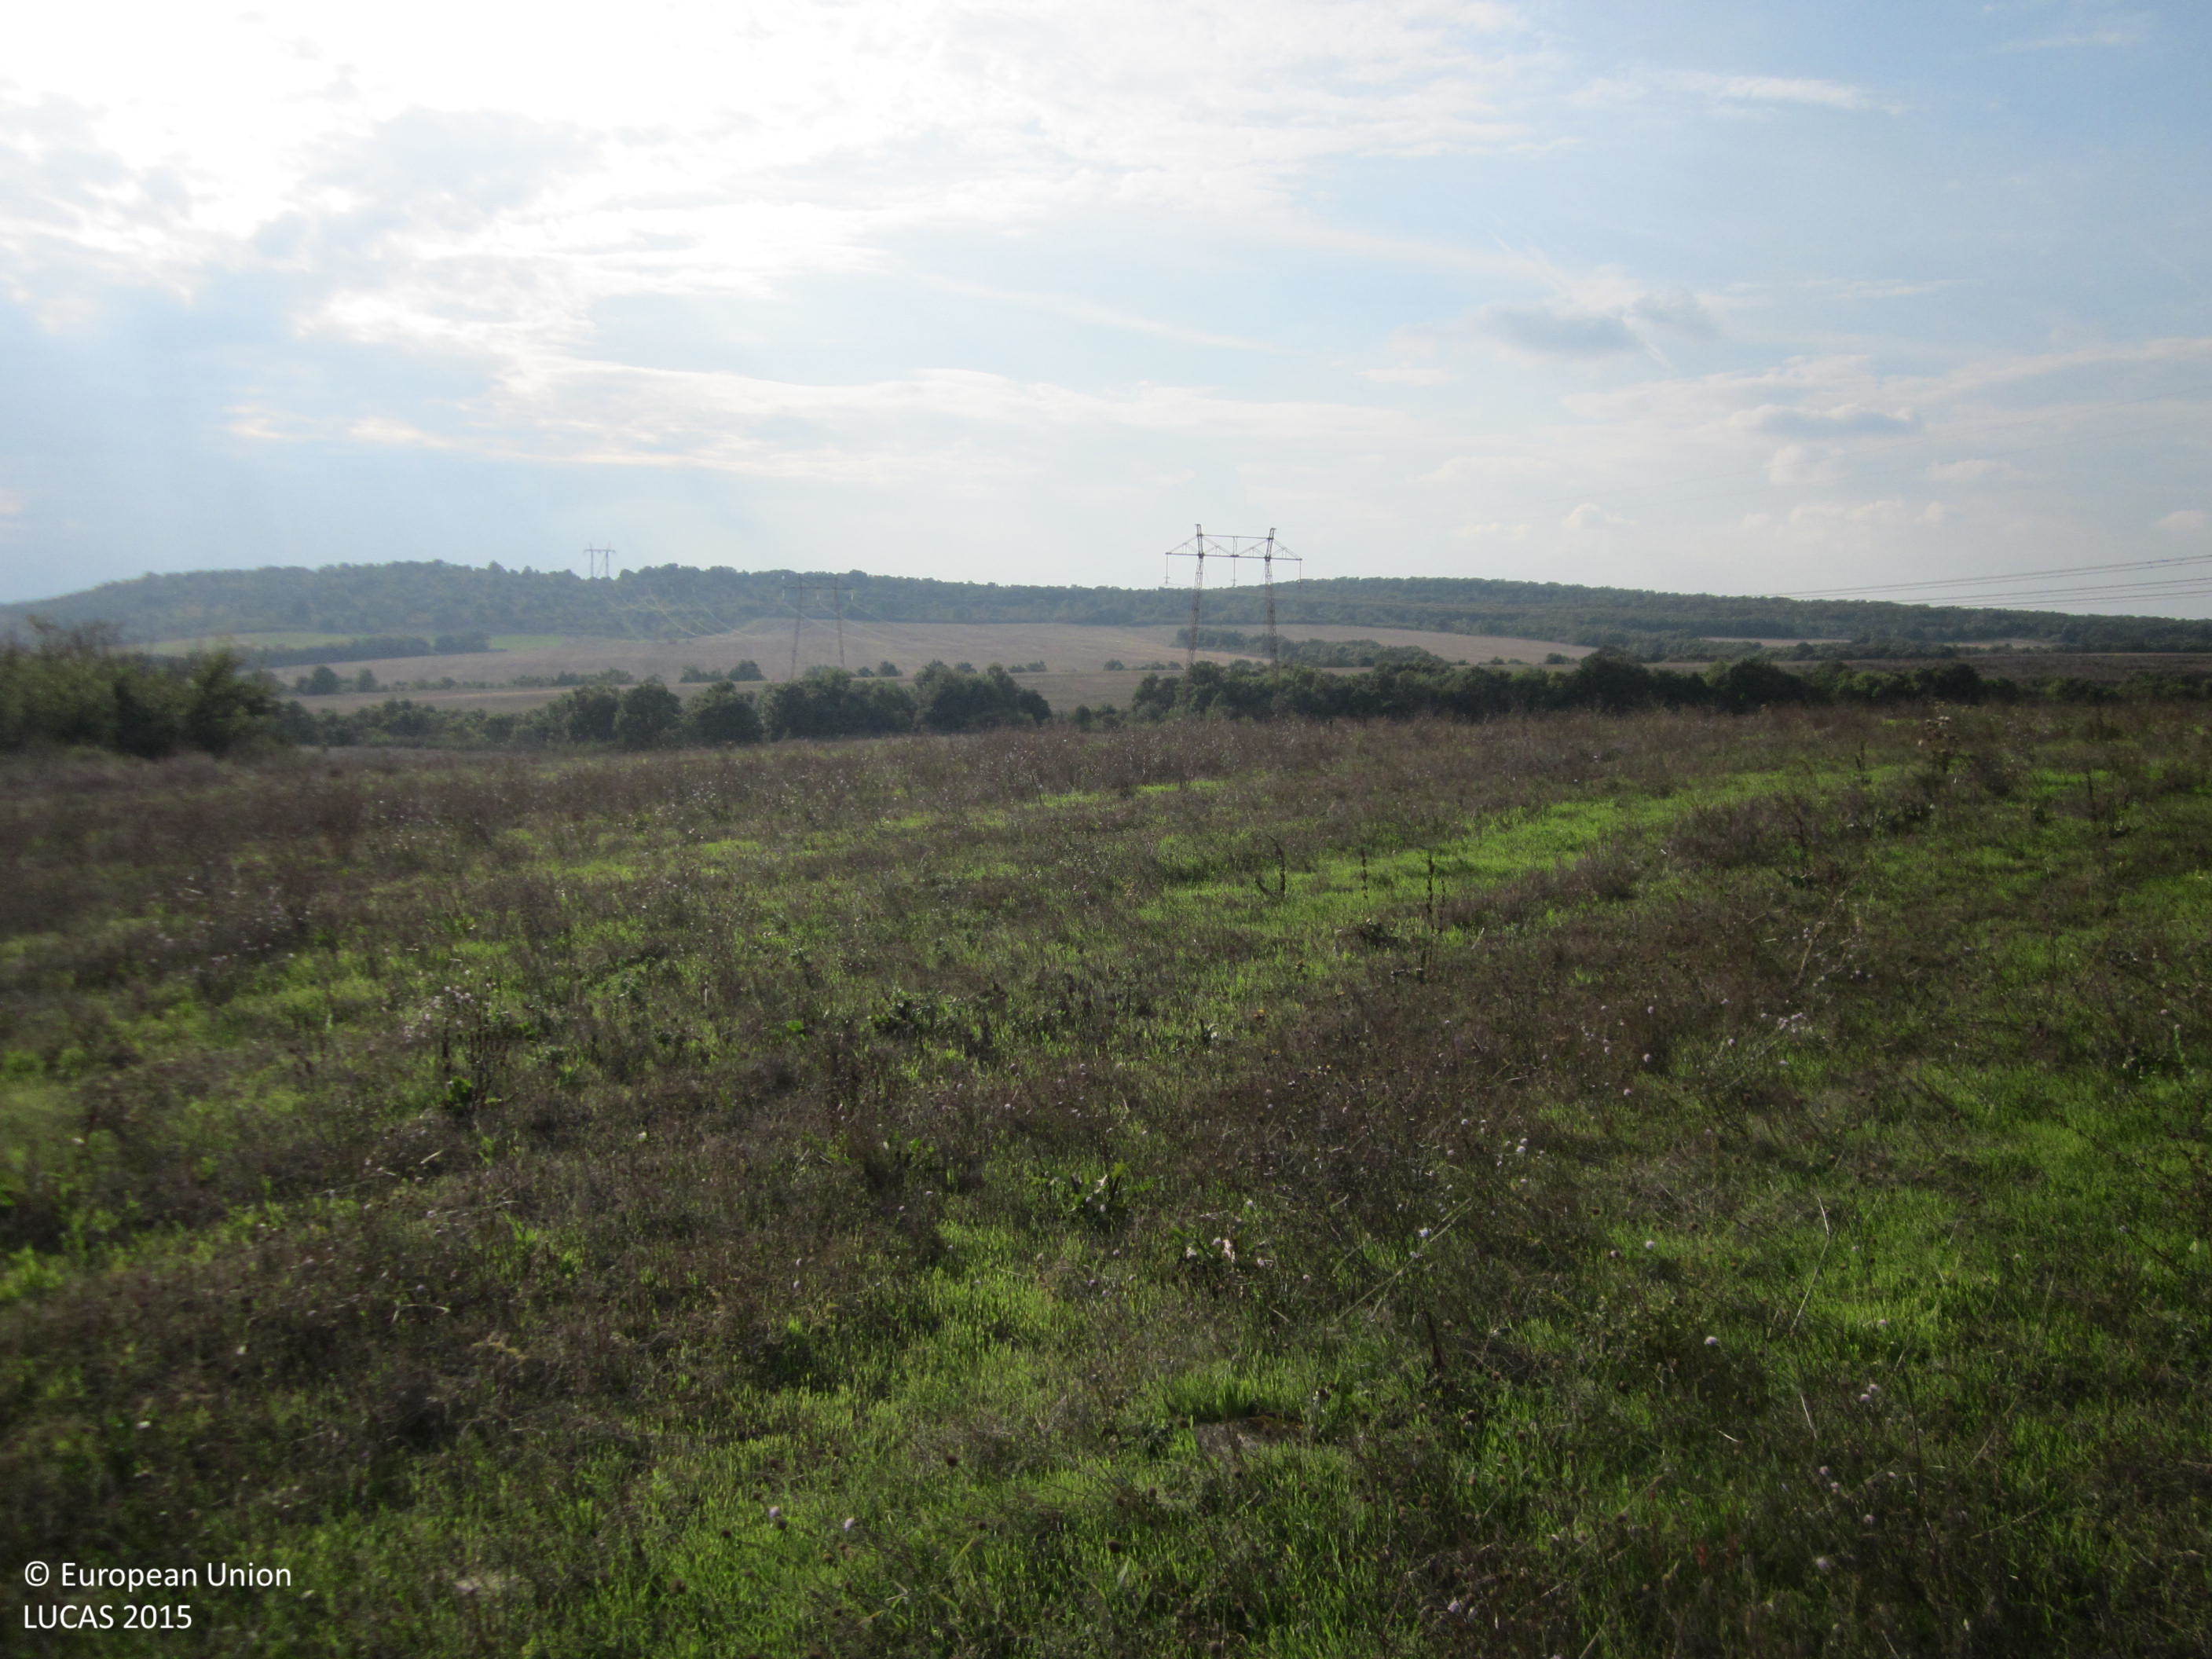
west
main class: Cropland
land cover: Barley
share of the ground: 10 - 25 %
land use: Agriculture (excluding fallow land and kitchen gardens)
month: October
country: BG
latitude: 42.3307
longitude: 26.9829
